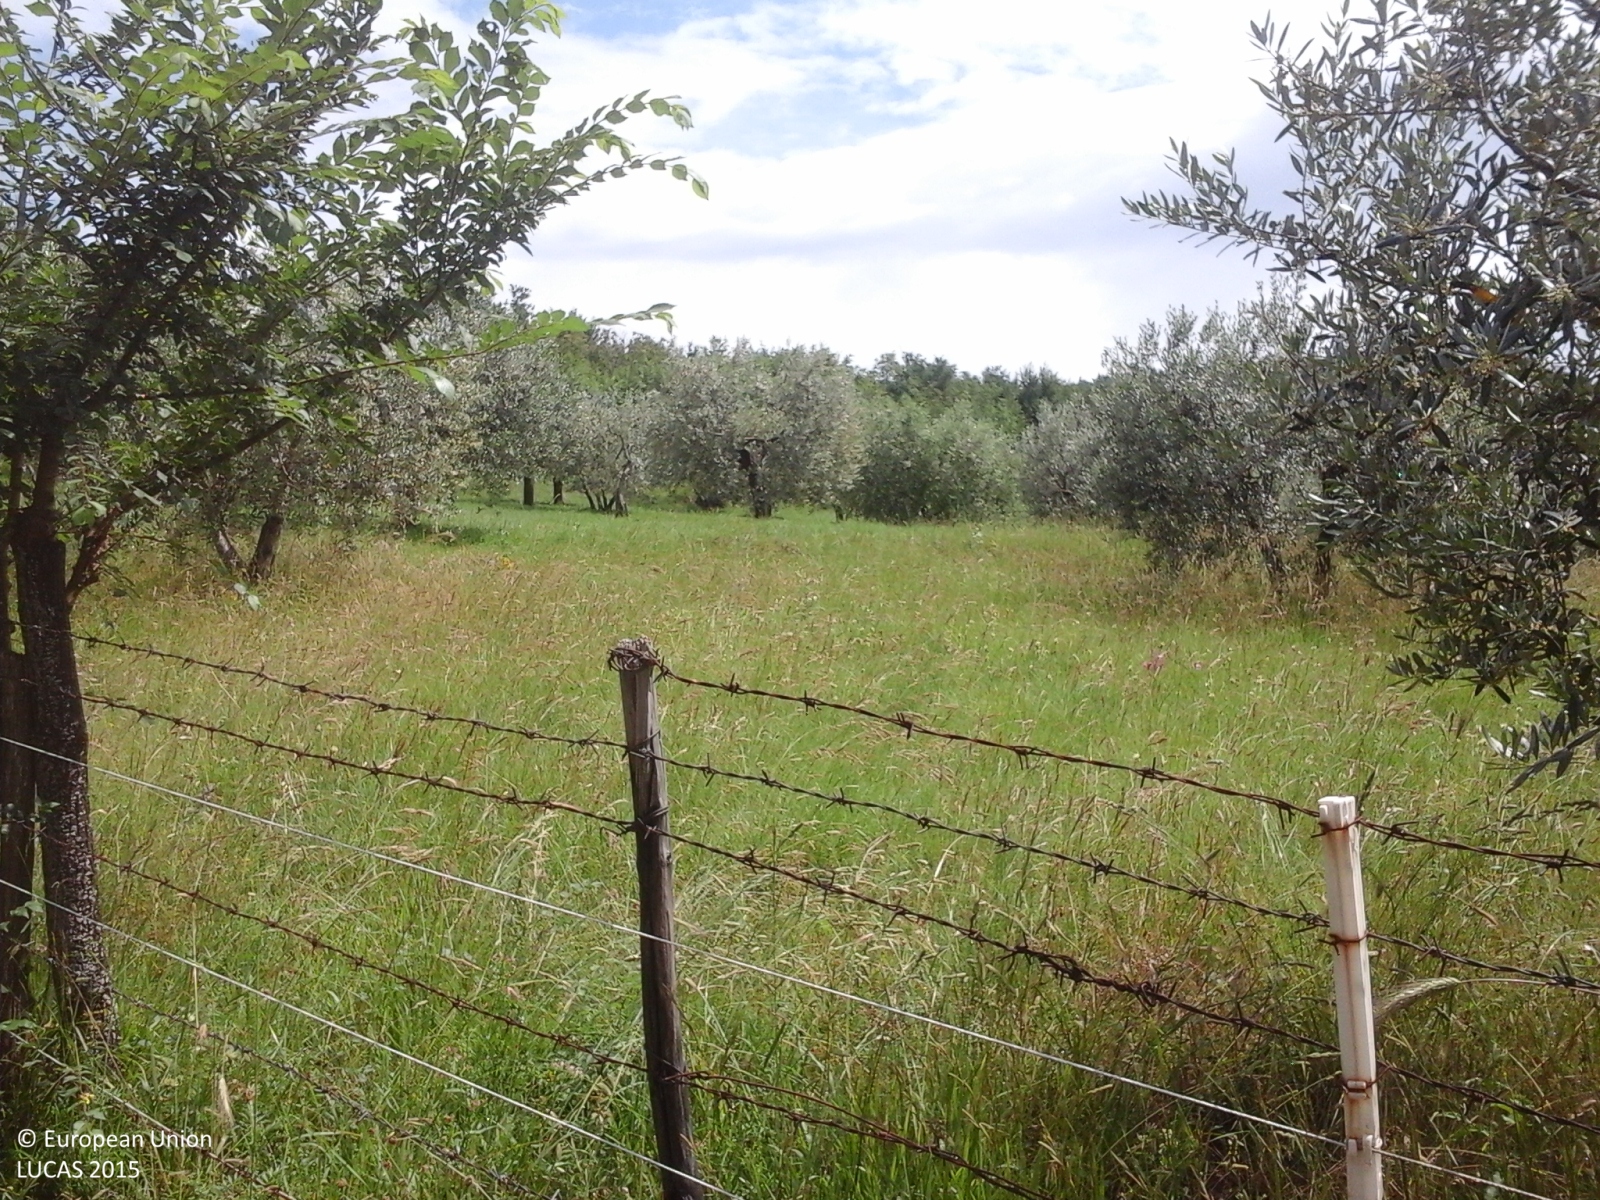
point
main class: Cropland
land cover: Olive groves
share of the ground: 25 - 50 %
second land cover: Grassland without tree/shrub cover
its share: > 75 %
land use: Agriculture (excluding fallow land and kitchen gardens)
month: June
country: IT
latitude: 42.1090
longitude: 12.8079
